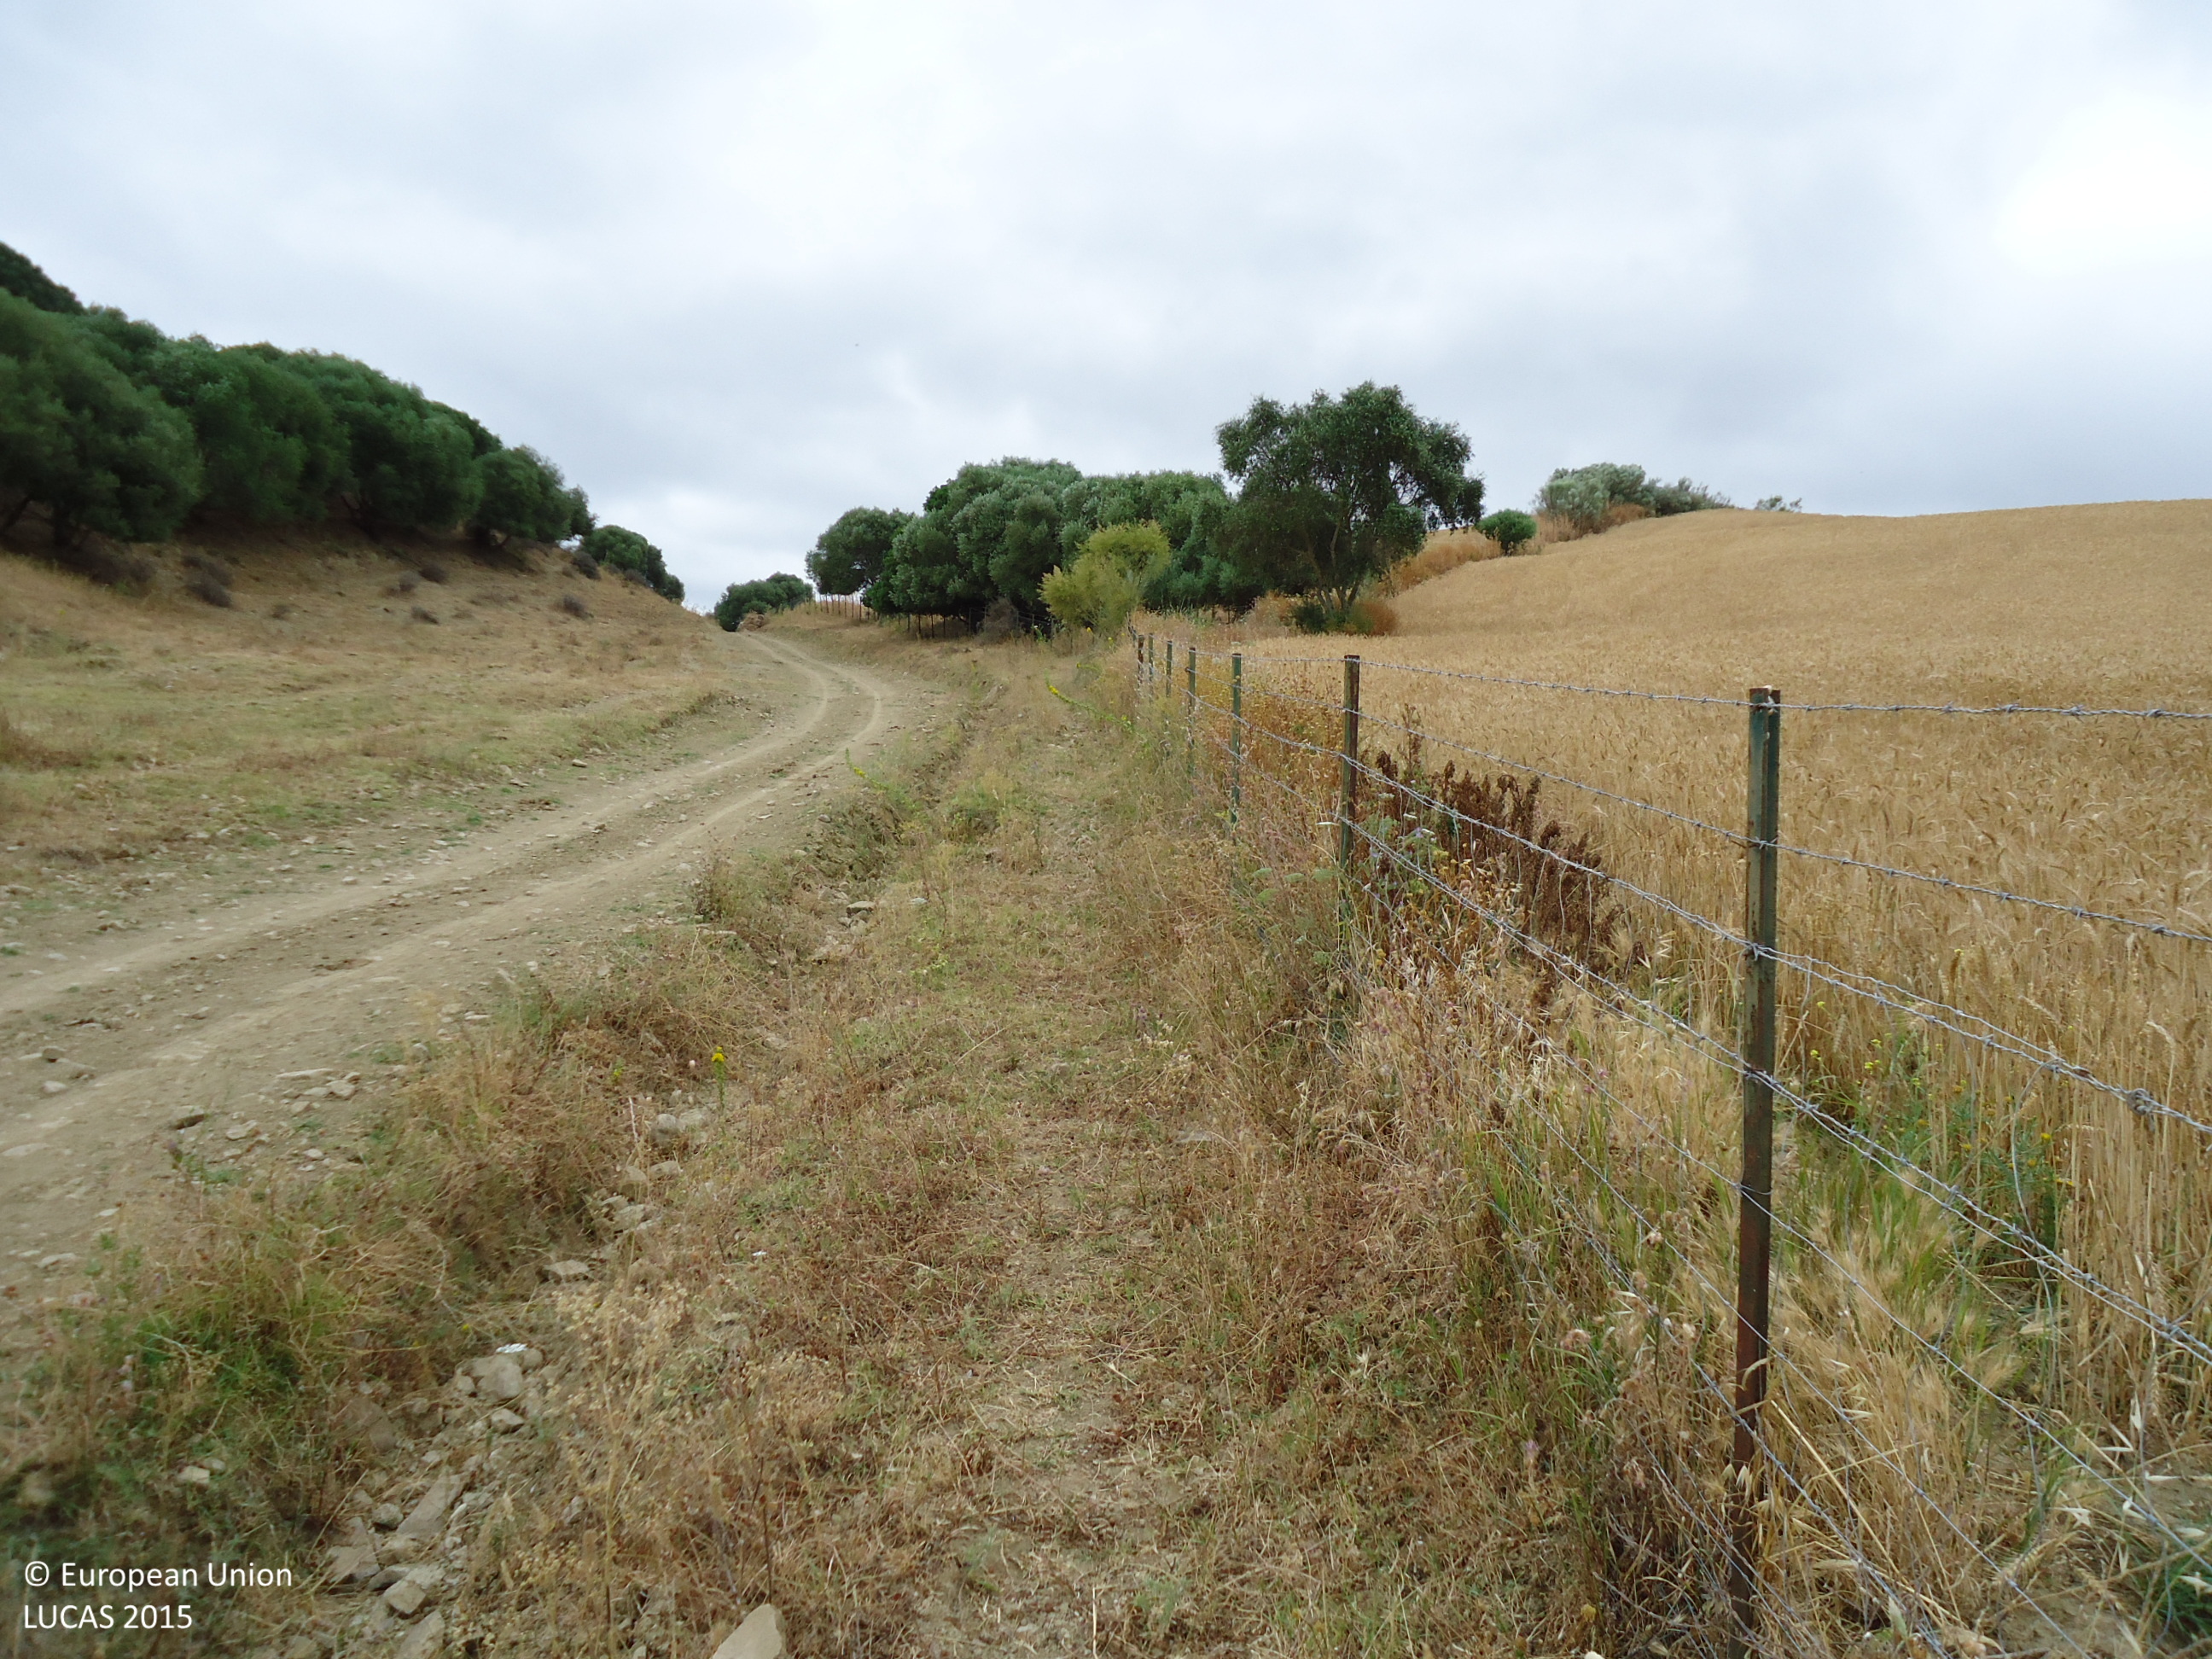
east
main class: Cropland
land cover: Barley
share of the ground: > 75 %
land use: Agriculture (excluding fallow land and kitchen gardens)
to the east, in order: Barley; Fences; Barley; Arable land (only in case pi); Broadleaved woodland; Arable land (only in case pi)
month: June
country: ES
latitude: 36.4154
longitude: -5.3747
